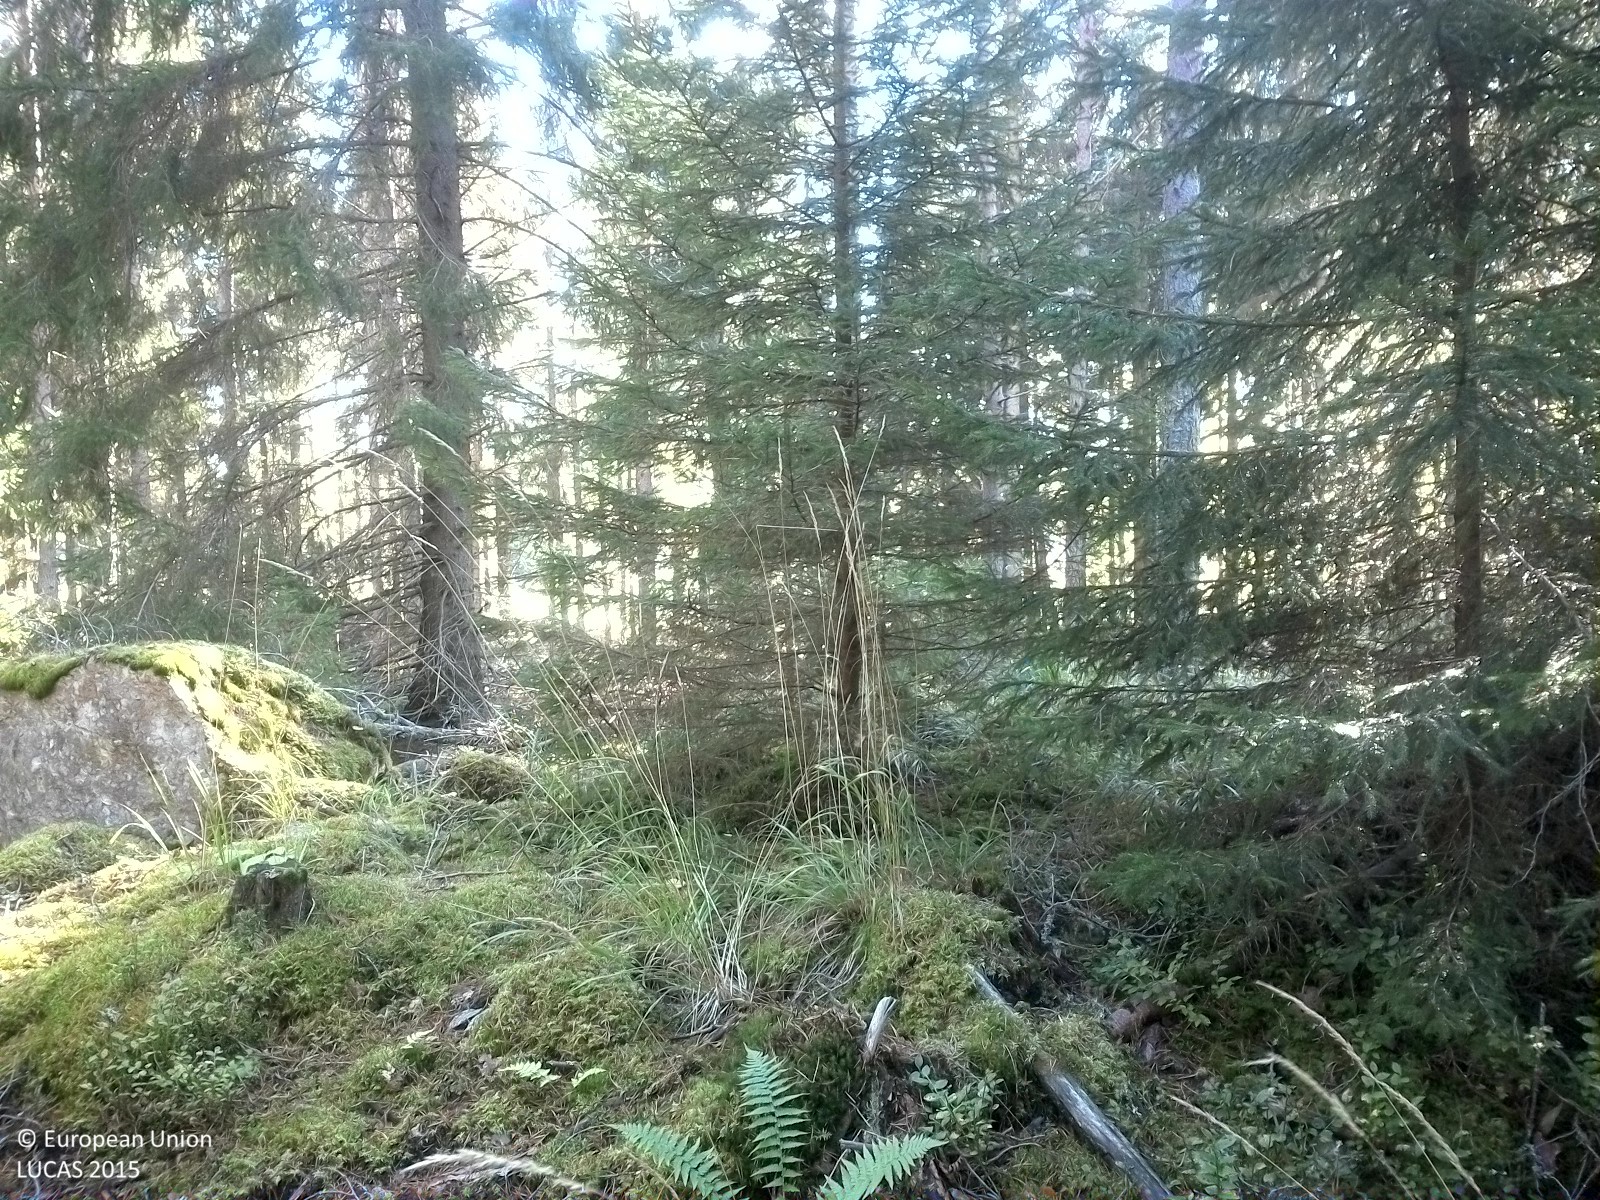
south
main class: Woodland
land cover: Pine dominated coniferous woodland
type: boreal forest
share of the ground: 25 - 50 %
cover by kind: coniferous forest trees 40 %, herbaceous plants 30 %, lichens and mosses 30 %
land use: Forestry
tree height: > 5 m
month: September
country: SE
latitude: 58.7690
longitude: 16.4448
